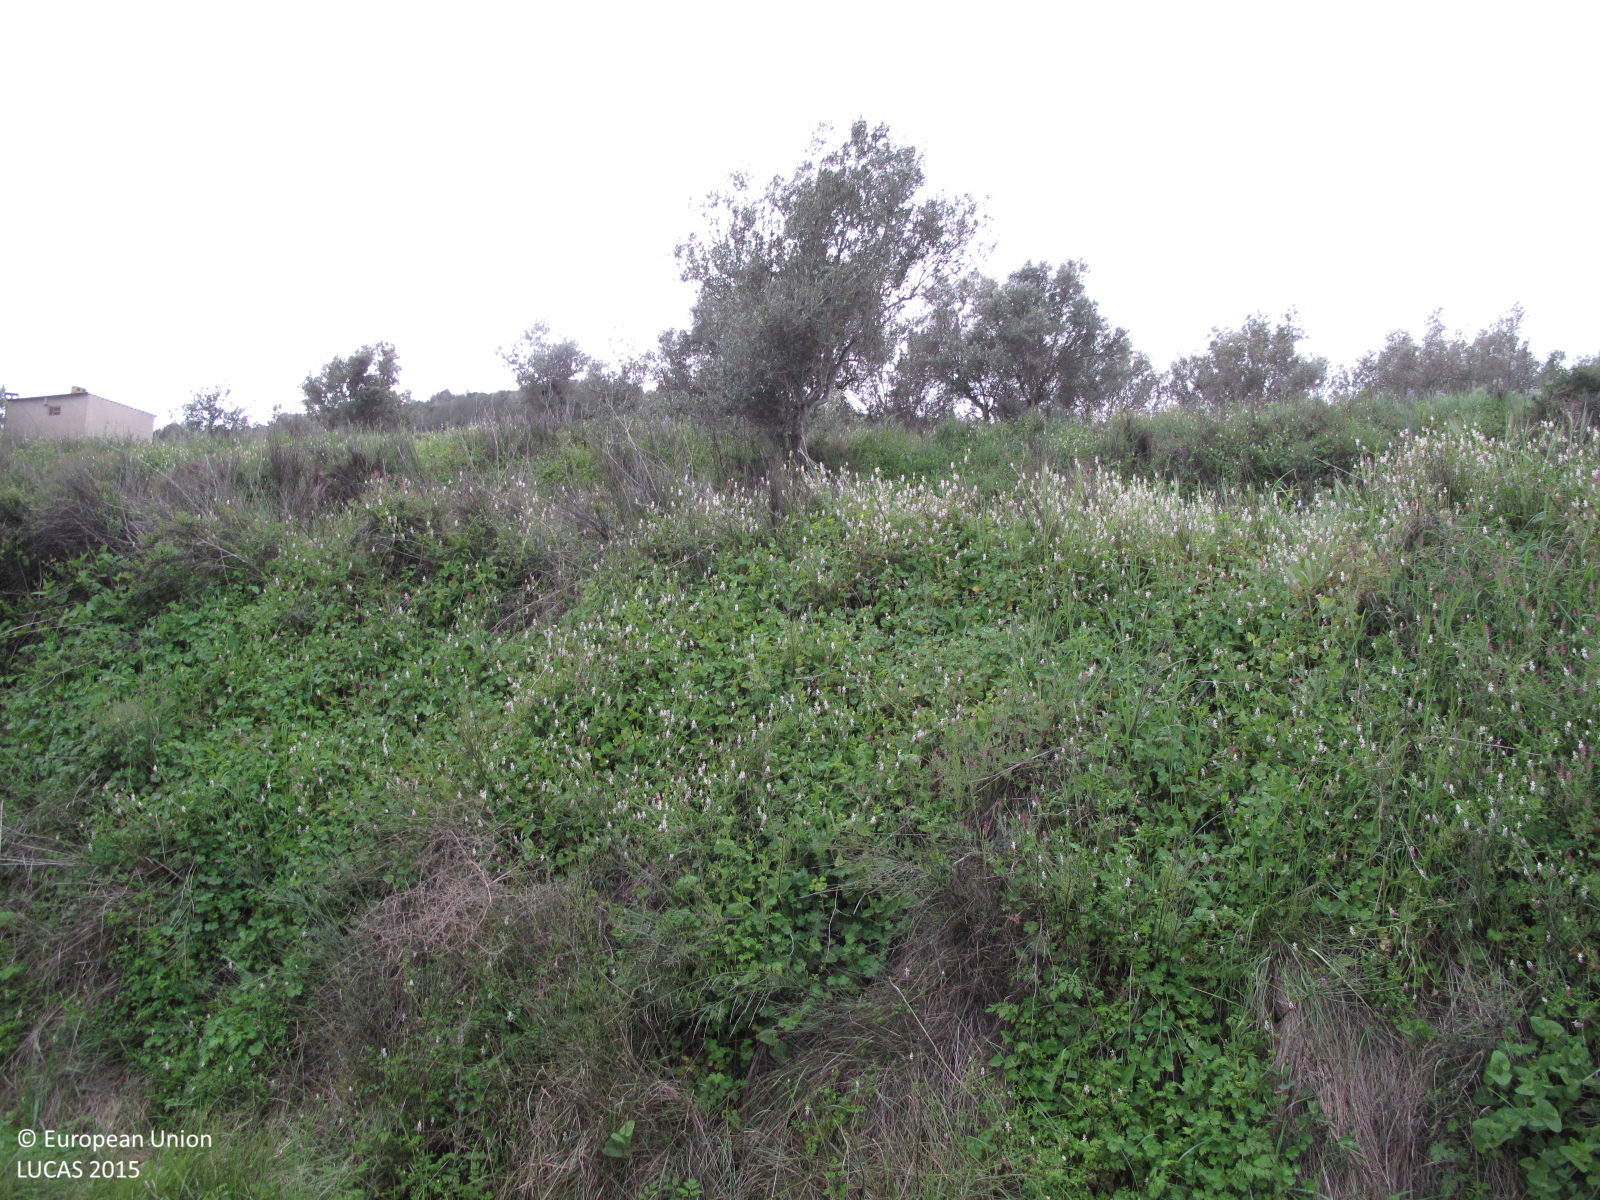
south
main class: Grassland
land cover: Grassland with sparse tree/shrub cover
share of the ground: > 75 %
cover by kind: herbaceous plants 90 %, broadleaved forest trees 5 %, shrubs 5 %
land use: Semi-natural and natural areas not in use
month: April
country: ES
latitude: 38.8722
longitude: -0.5841
